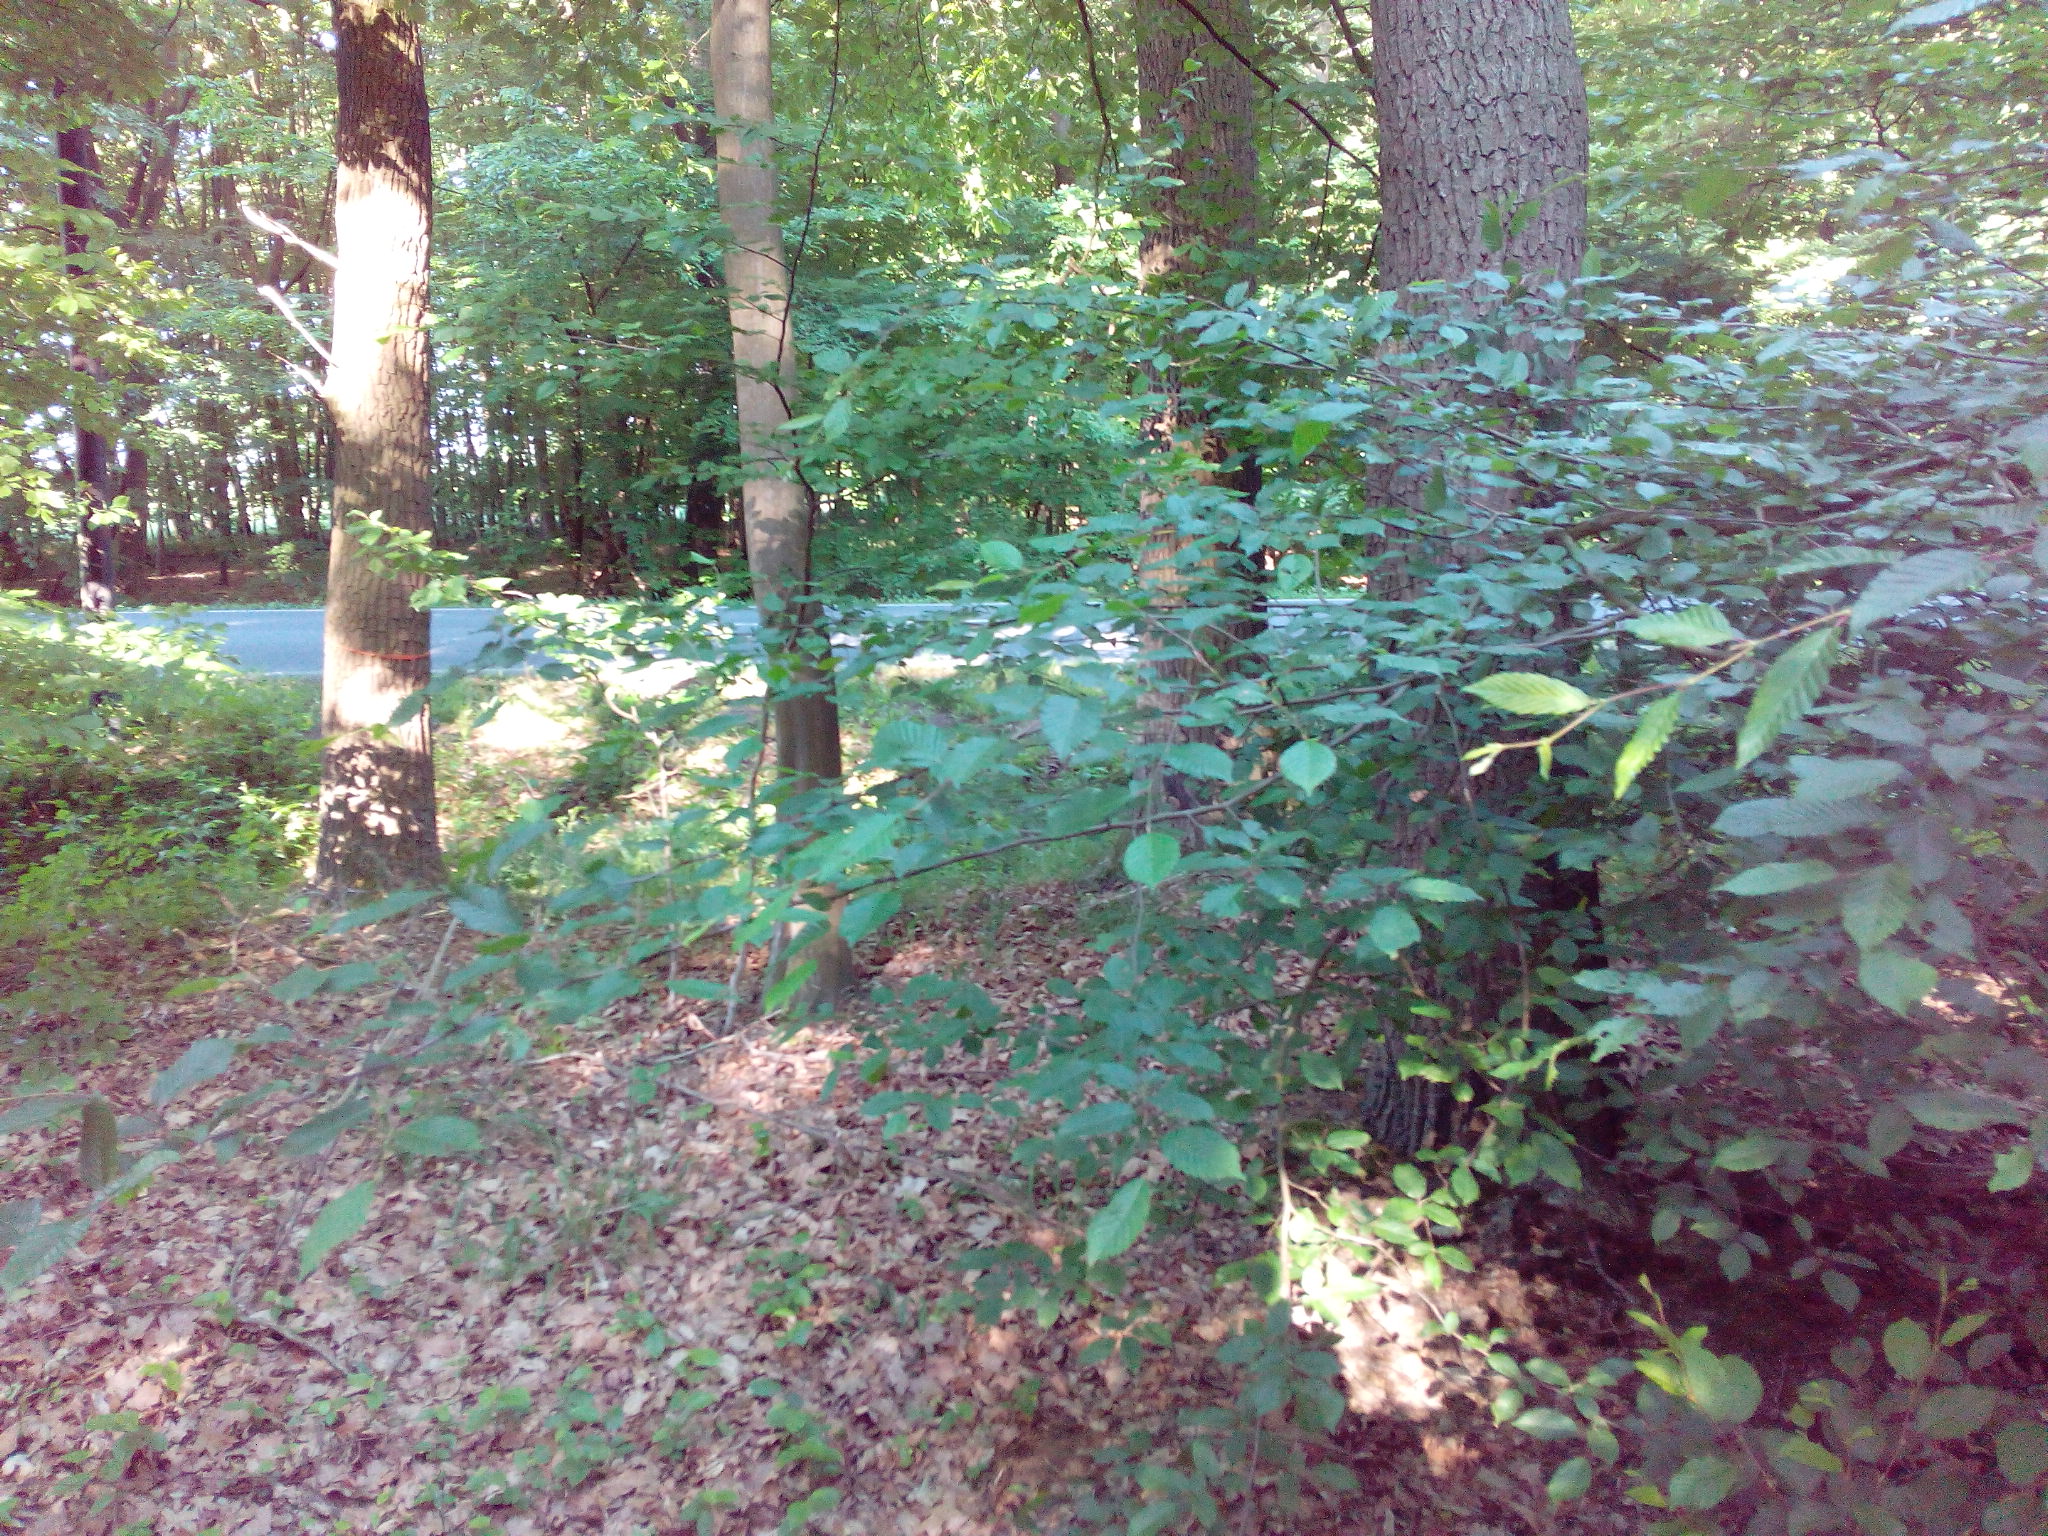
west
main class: Woodland
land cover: Broadleaved woodland
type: hemiboreal forest and nemoral coniferous forest and mixed broadleaved-coniferous forest
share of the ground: > 75 %
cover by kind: broadleaved forest trees 90 %, shrubs 5 %, herbaceous plants 5 %
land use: Forestry
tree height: > 5 m
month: June
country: DE
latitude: 52.3055
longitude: 9.8974
